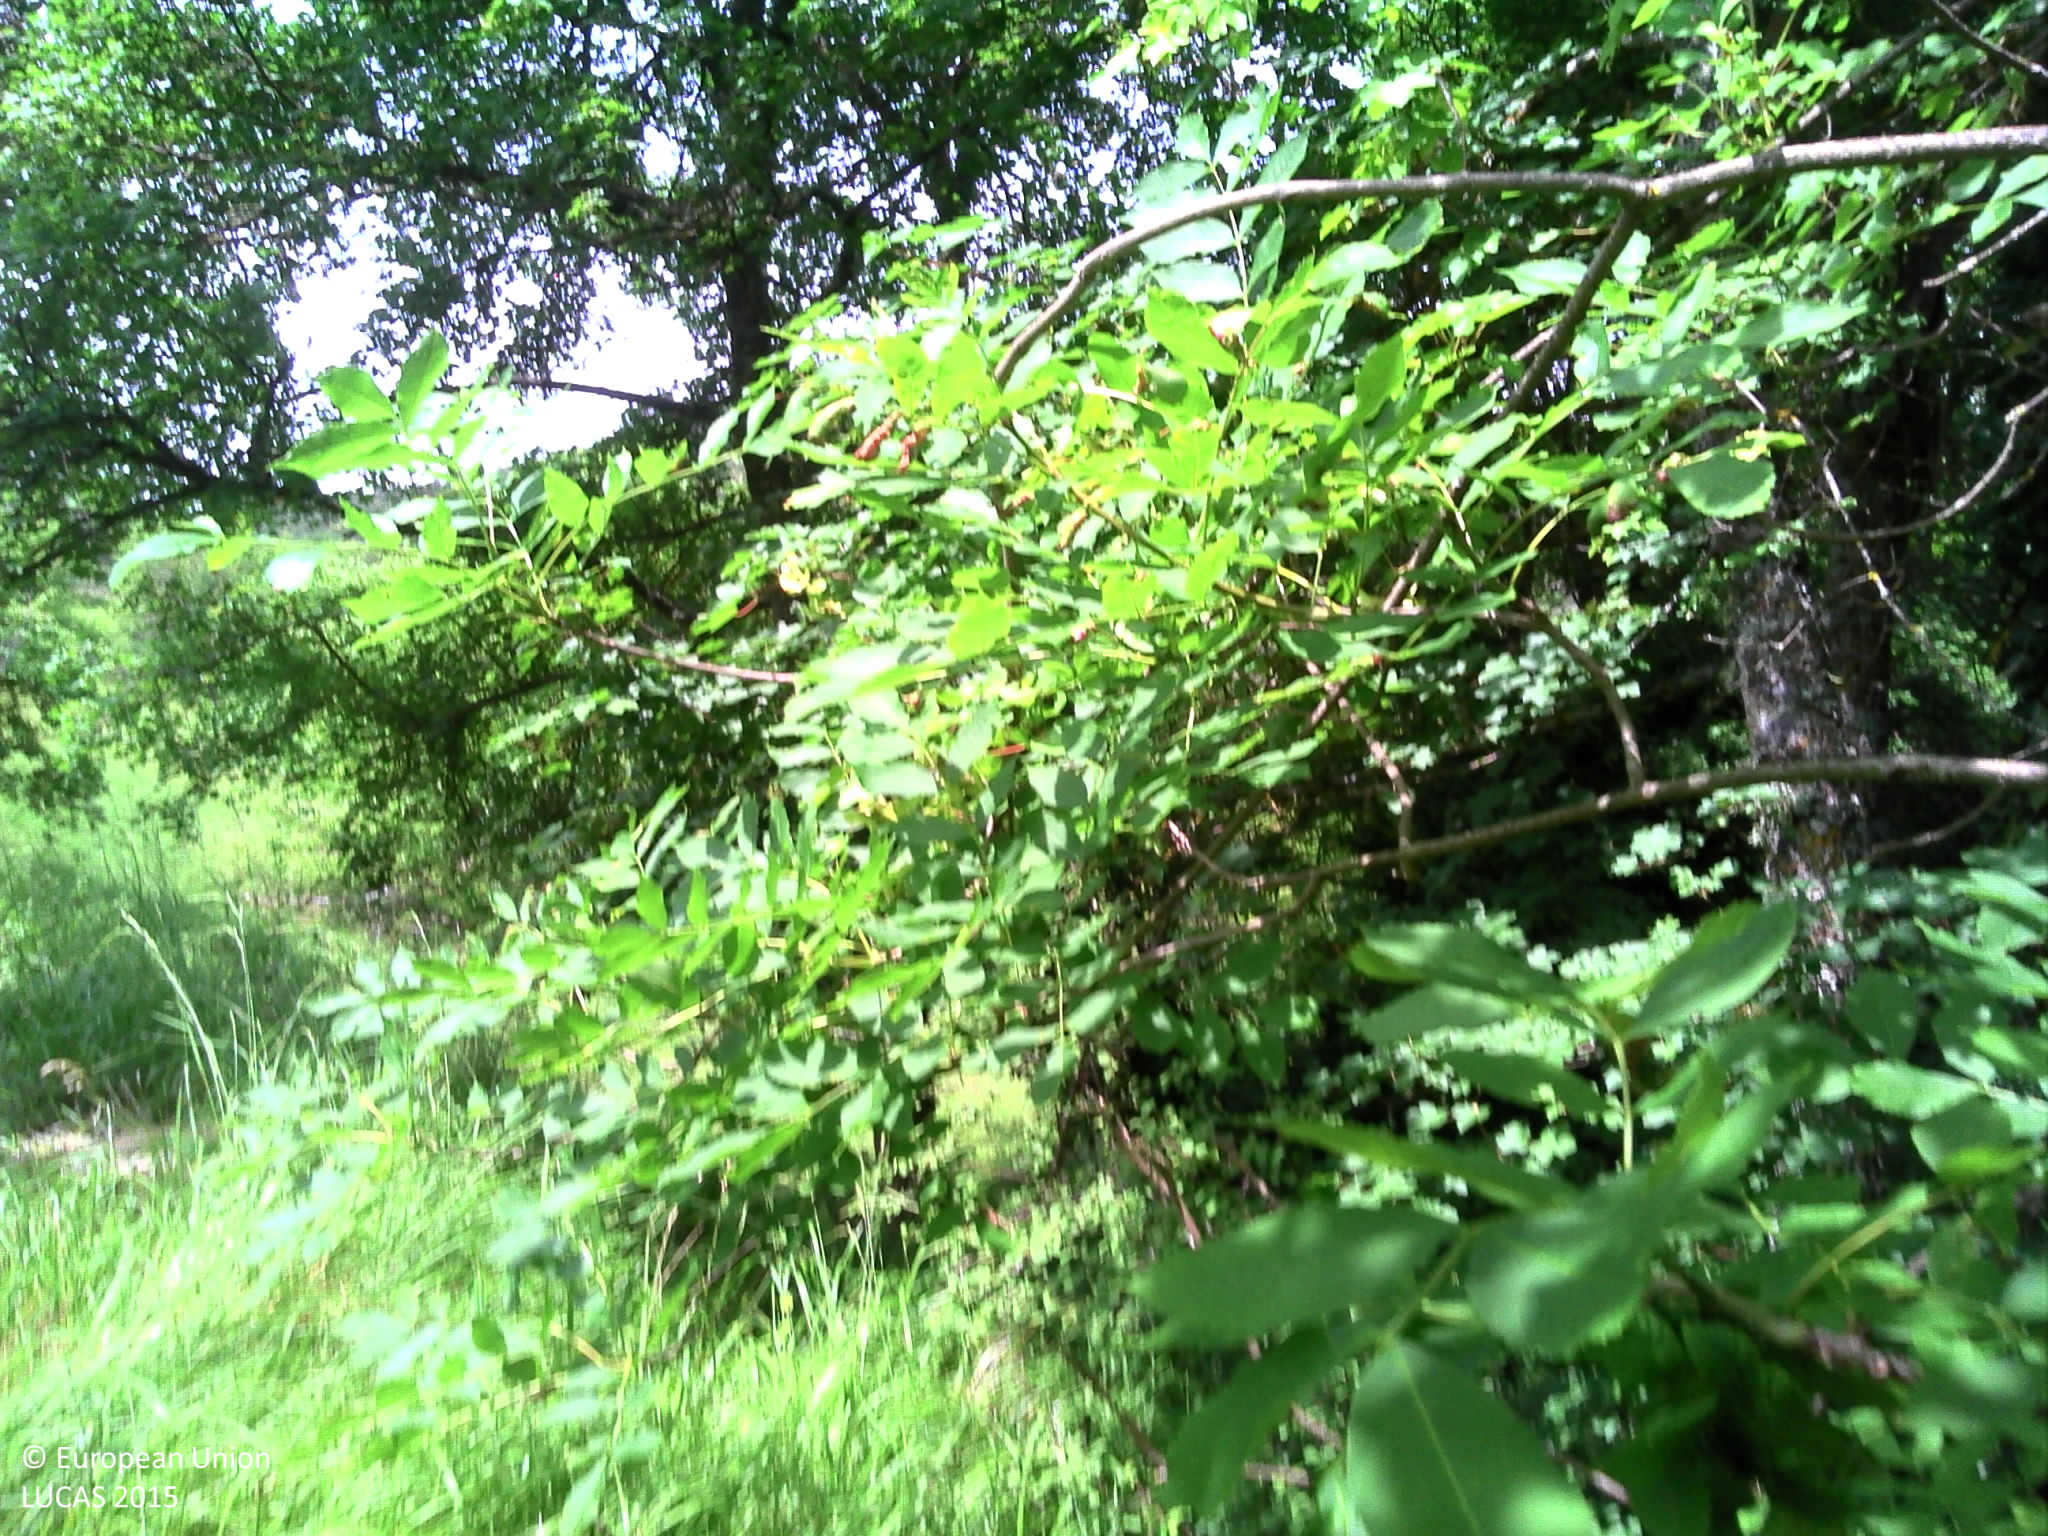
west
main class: Woodland
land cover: Broadleaved woodland
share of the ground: > 75 %
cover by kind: herbaceous plants 85 %, broadleaved forest trees 10 %, shrubs 5 %
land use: Agriculture (excluding fallow land and kitchen gardens)
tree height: > 5 m
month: June
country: FR
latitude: 44.7462
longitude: 5.2195
